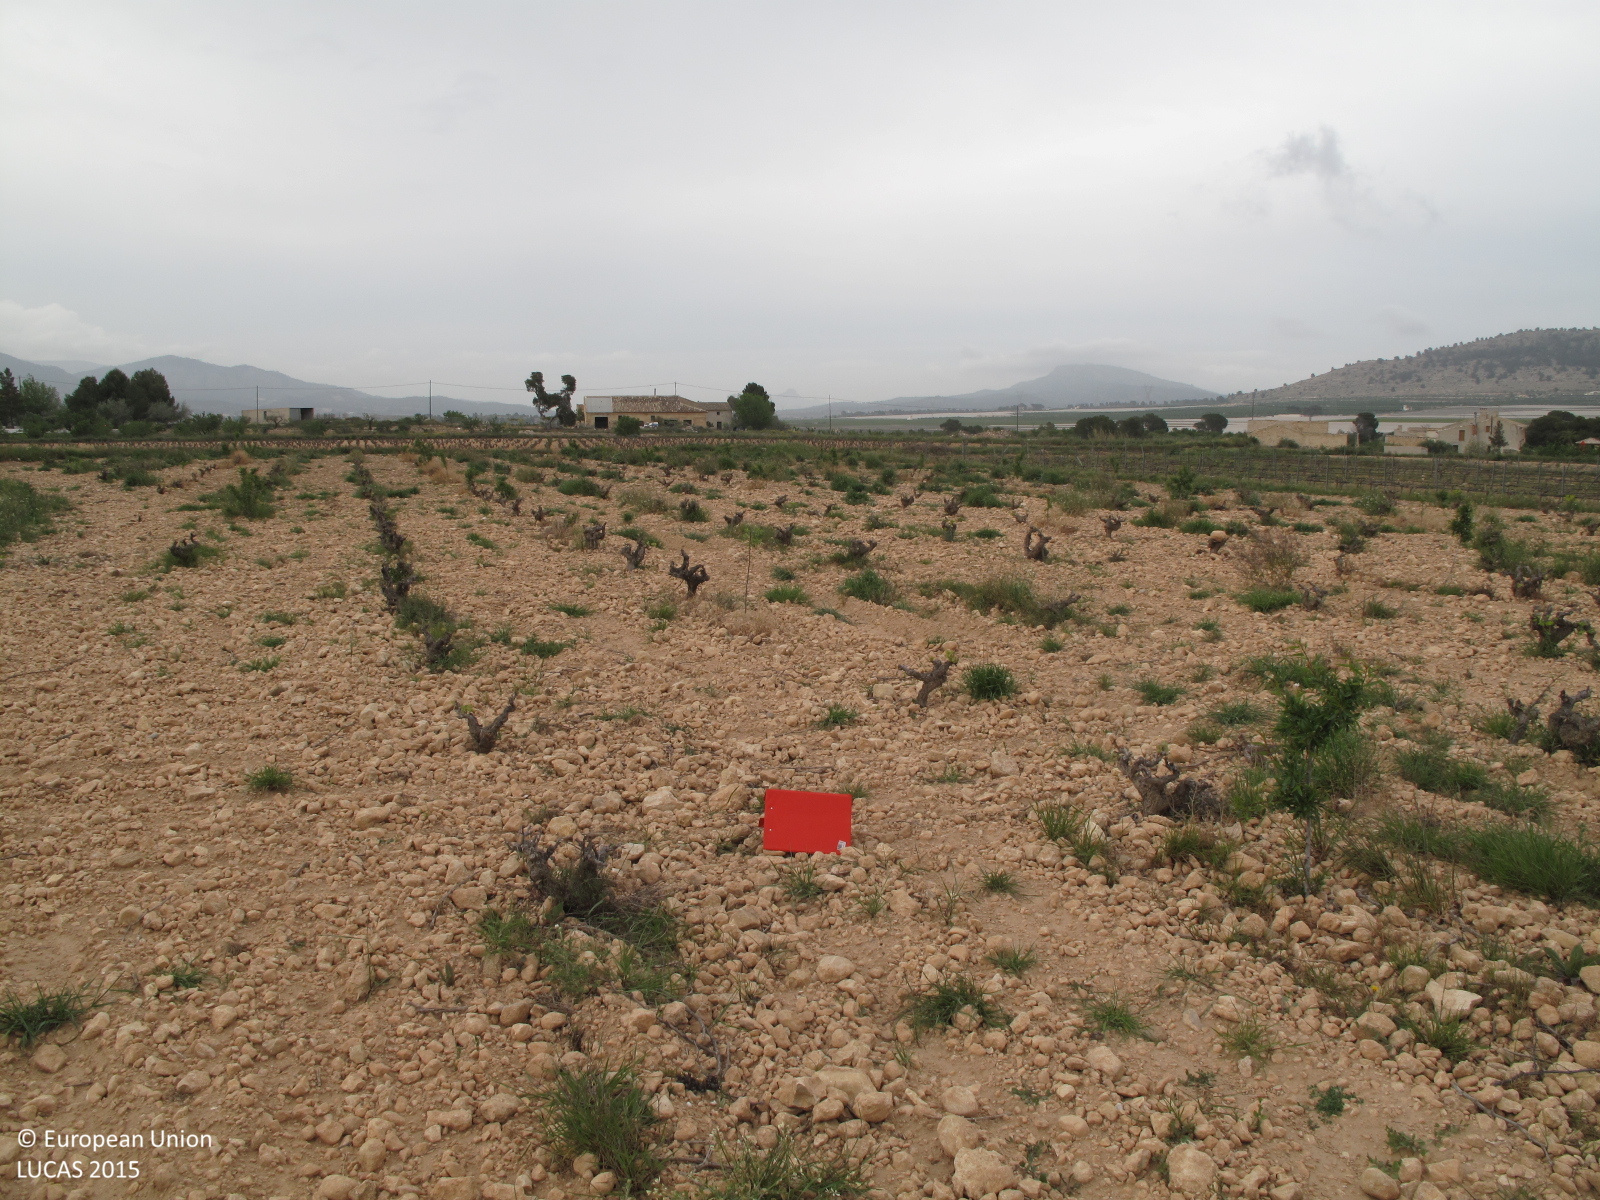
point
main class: Cropland
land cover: Vineyards
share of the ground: < 10 %
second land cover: Nuts trees
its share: < 10 %
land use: Agriculture (excluding fallow land and kitchen gardens)
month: April
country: ES
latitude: 38.4139
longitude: -0.9254
